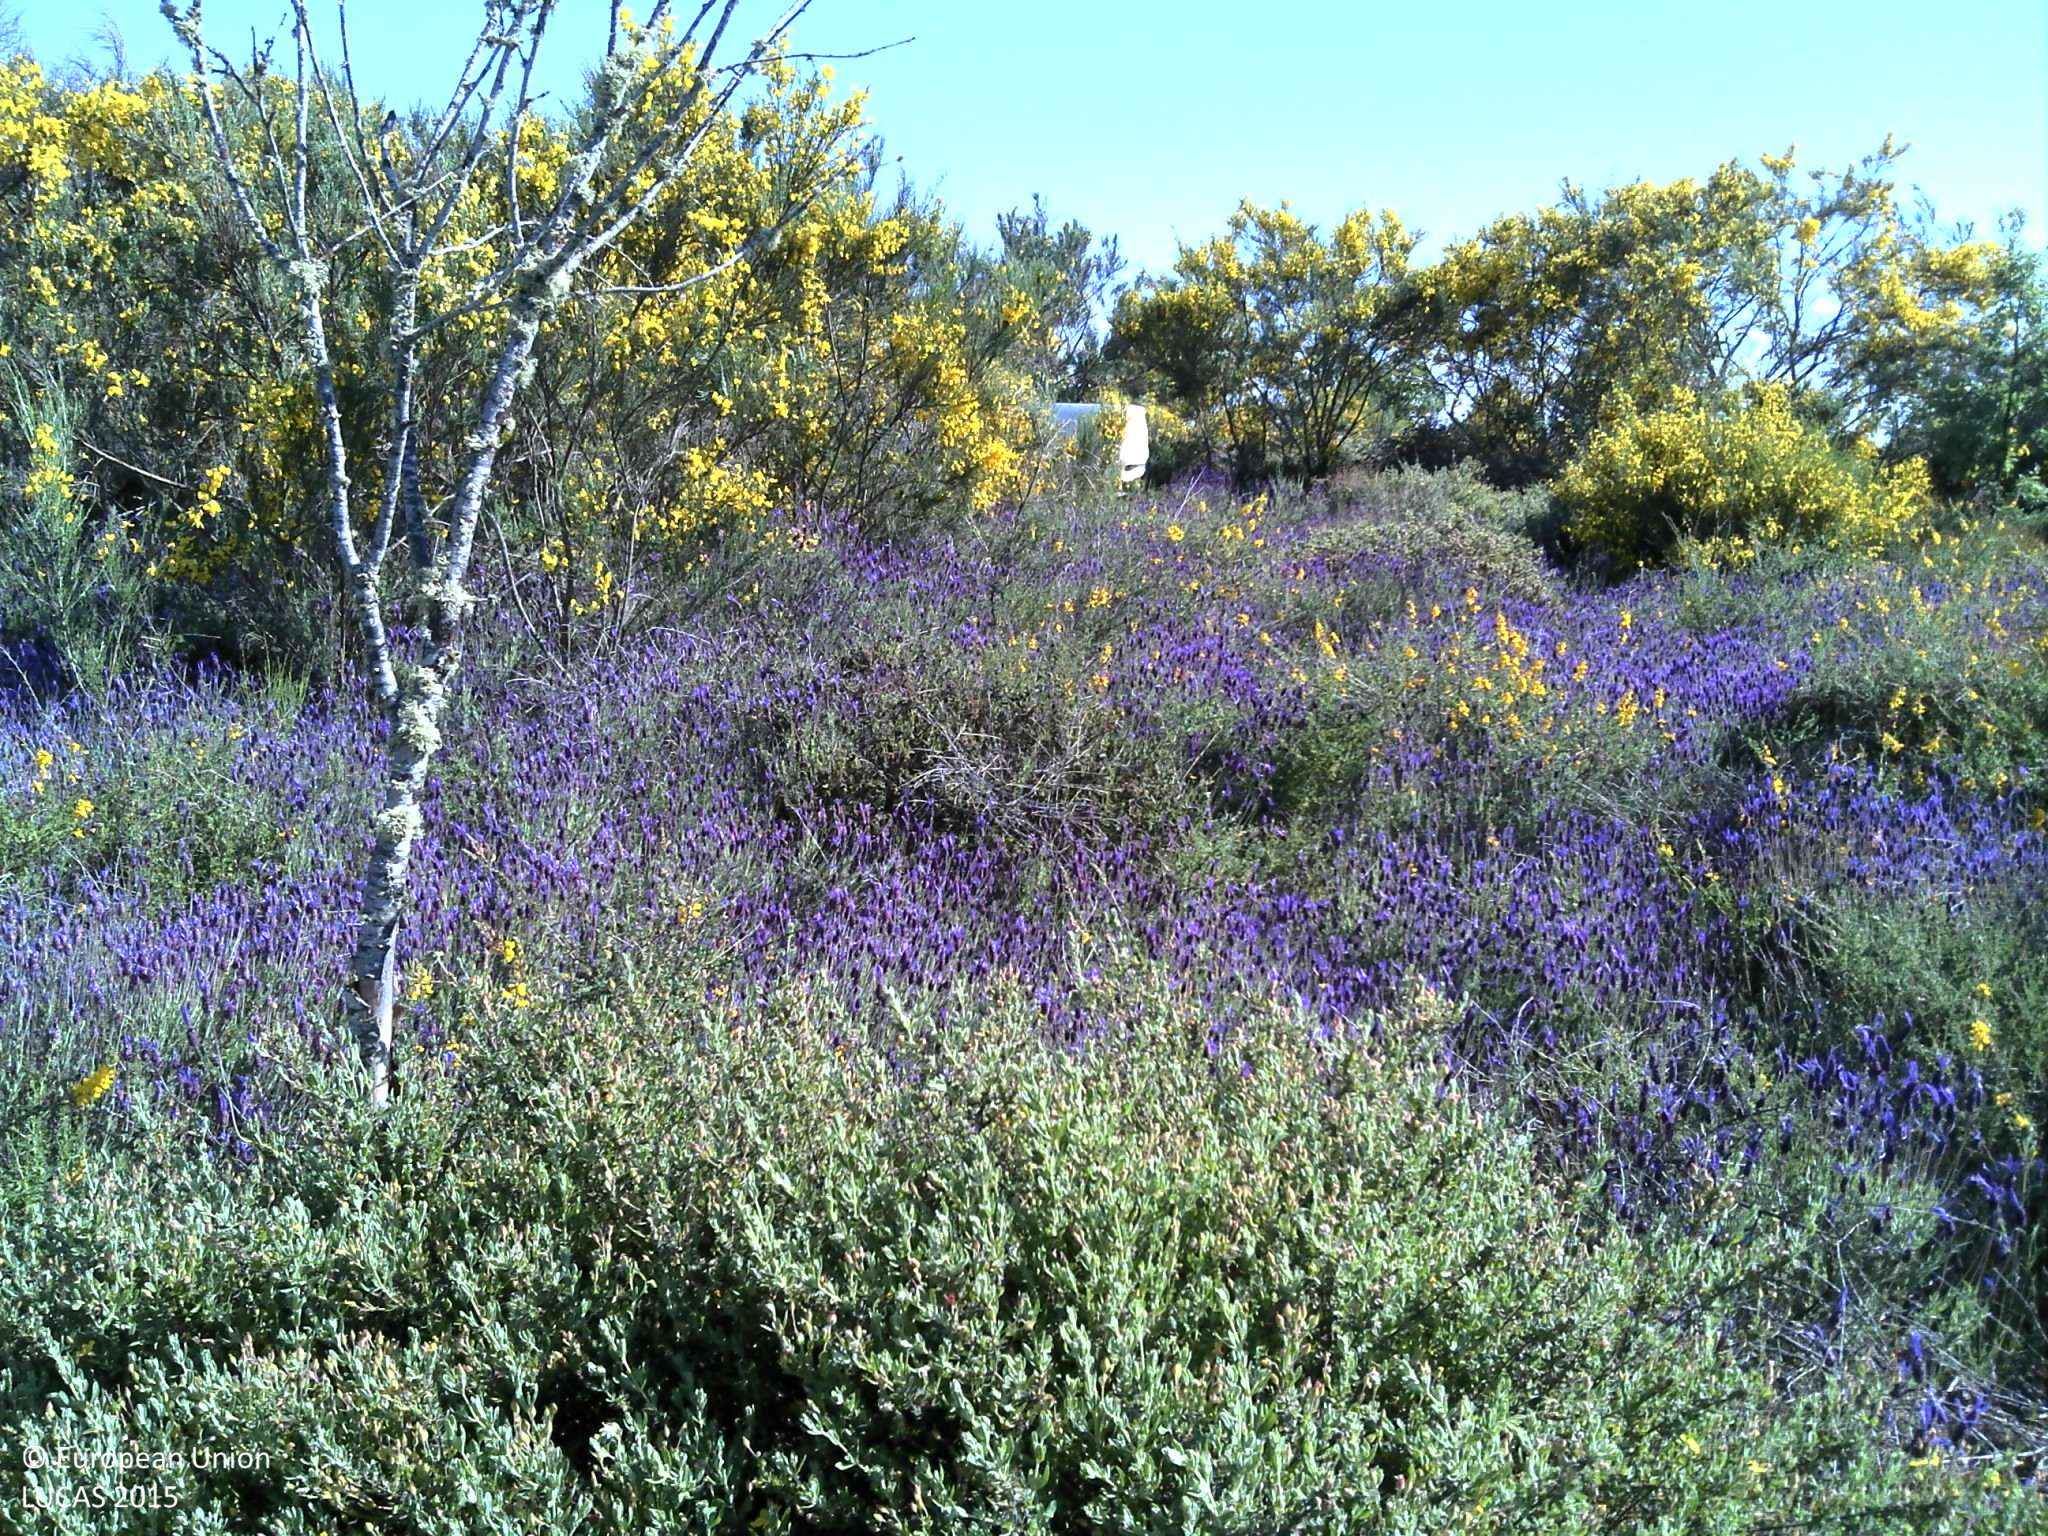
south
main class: Shrubland
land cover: Shrubland with sparse tree cover
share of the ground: > 75 %
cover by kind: shrubs 90 %, broadleaved forest trees 5 %, herbaceous plants 5 %
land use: Abandoned areas
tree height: < 5 m
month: May
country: PT
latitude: 41.6427
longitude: -6.3698
